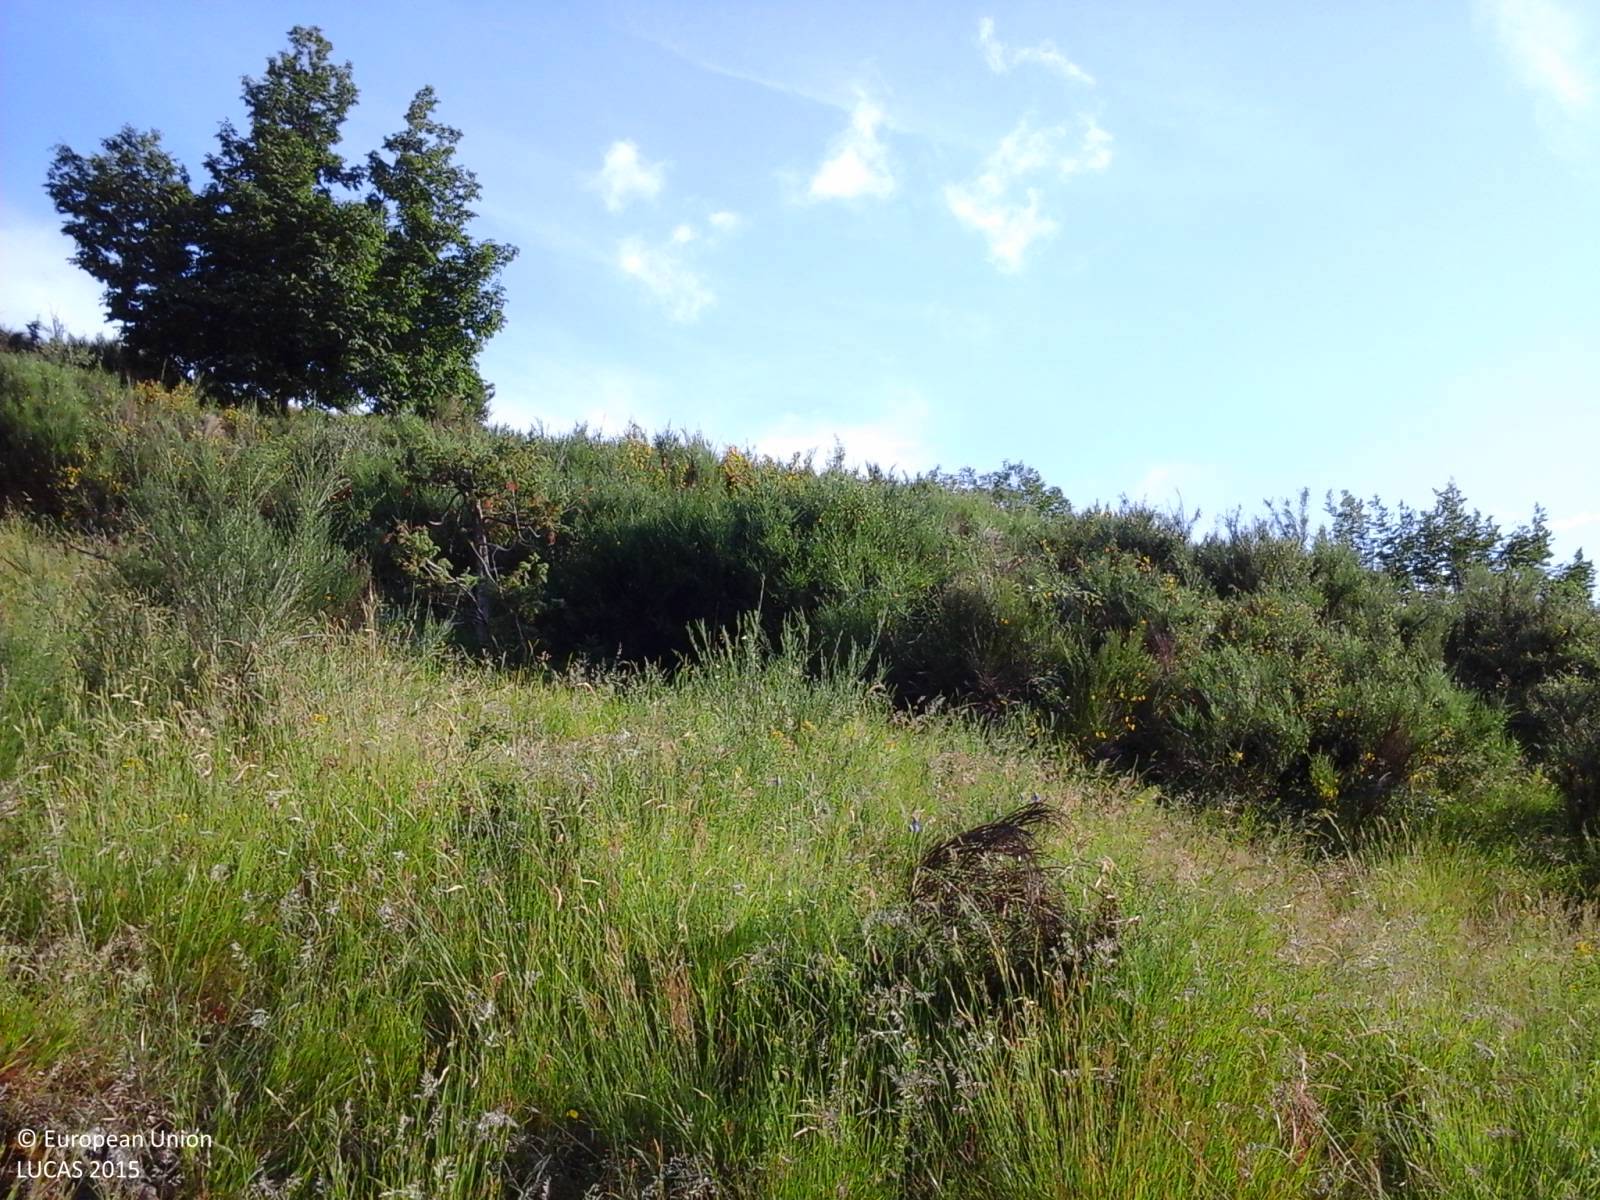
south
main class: Shrubland
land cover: Shrubland without tree cover
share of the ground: > 75 %
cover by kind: shrubs 50 %, herbaceous plants 30 %, consolidated bare surface 20 %
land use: Semi-natural and natural areas not in use
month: June
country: IT
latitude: 44.0601
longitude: 10.6102
